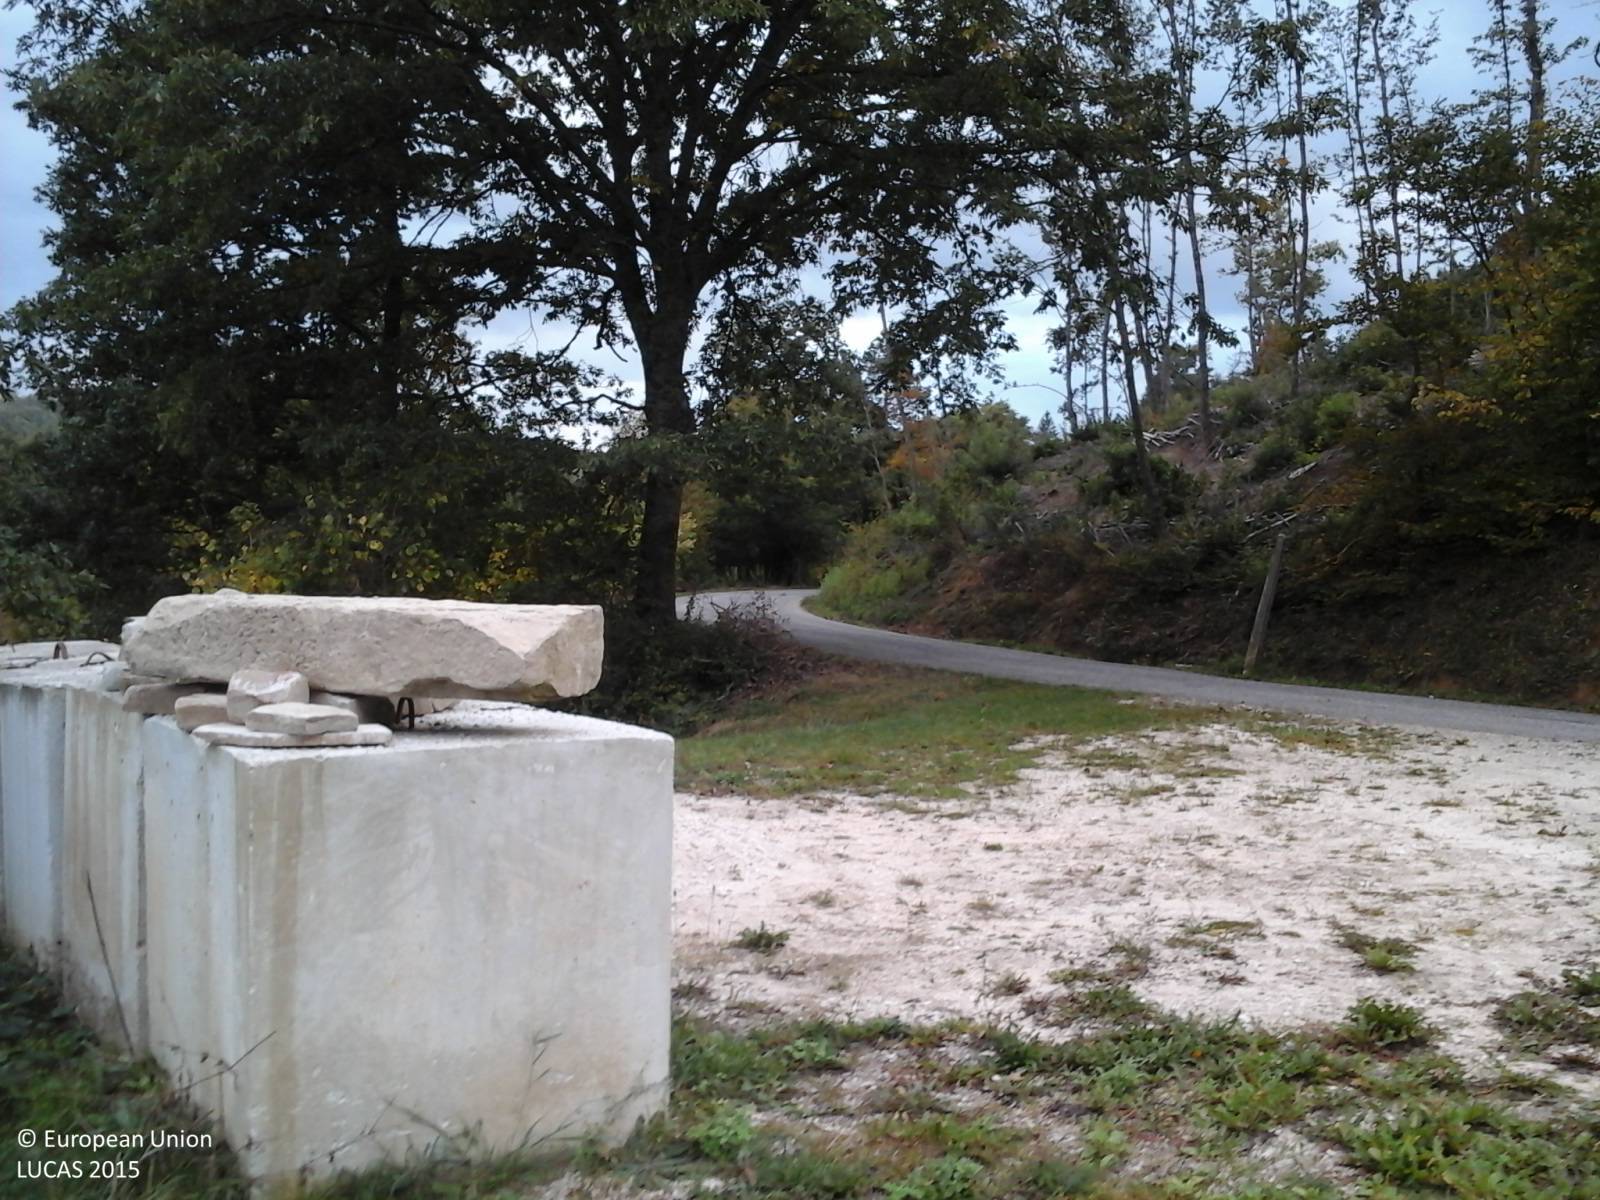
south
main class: Woodland
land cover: Broadleaved woodland
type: thermophilous deciduous forest
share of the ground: > 75 %
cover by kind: broadleaved forest trees 100 %
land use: Forestry
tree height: > 5 m
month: October
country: IT
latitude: 42.6562
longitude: 13.2472
